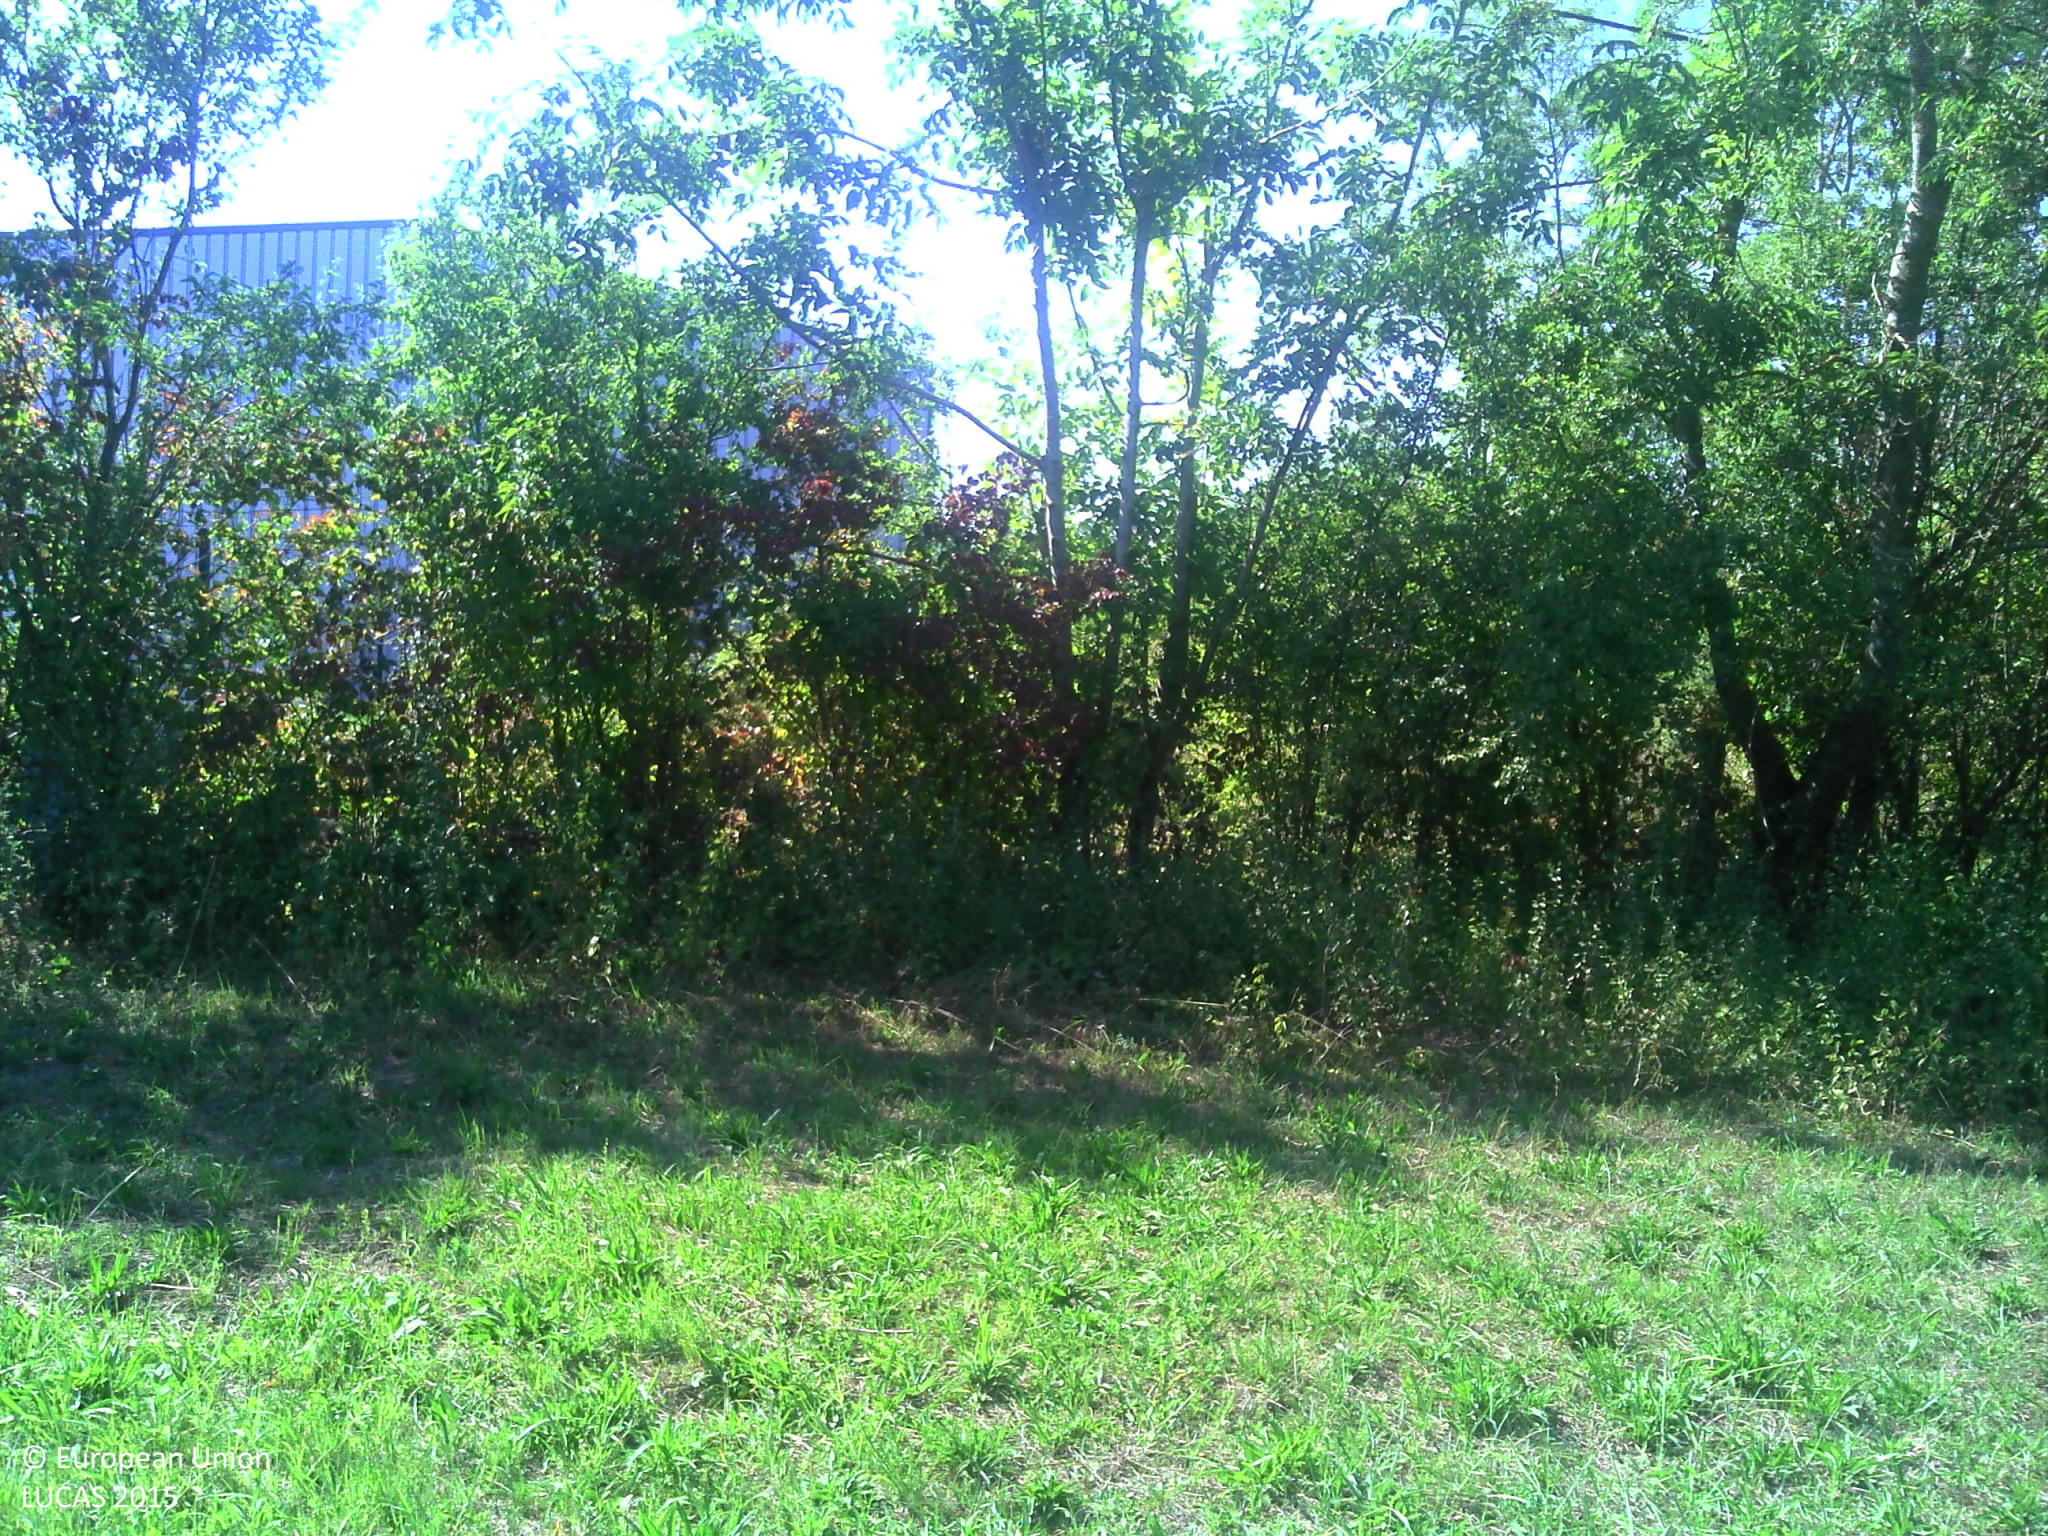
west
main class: Cropland
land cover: Other fruit trees and berries
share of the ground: > 75 %
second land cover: Grassland without tree/shrub cover
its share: > 75 %
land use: Agriculture (excluding fallow land and kitchen gardens)
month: September
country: FR
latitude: 48.8264
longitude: 6.2541
